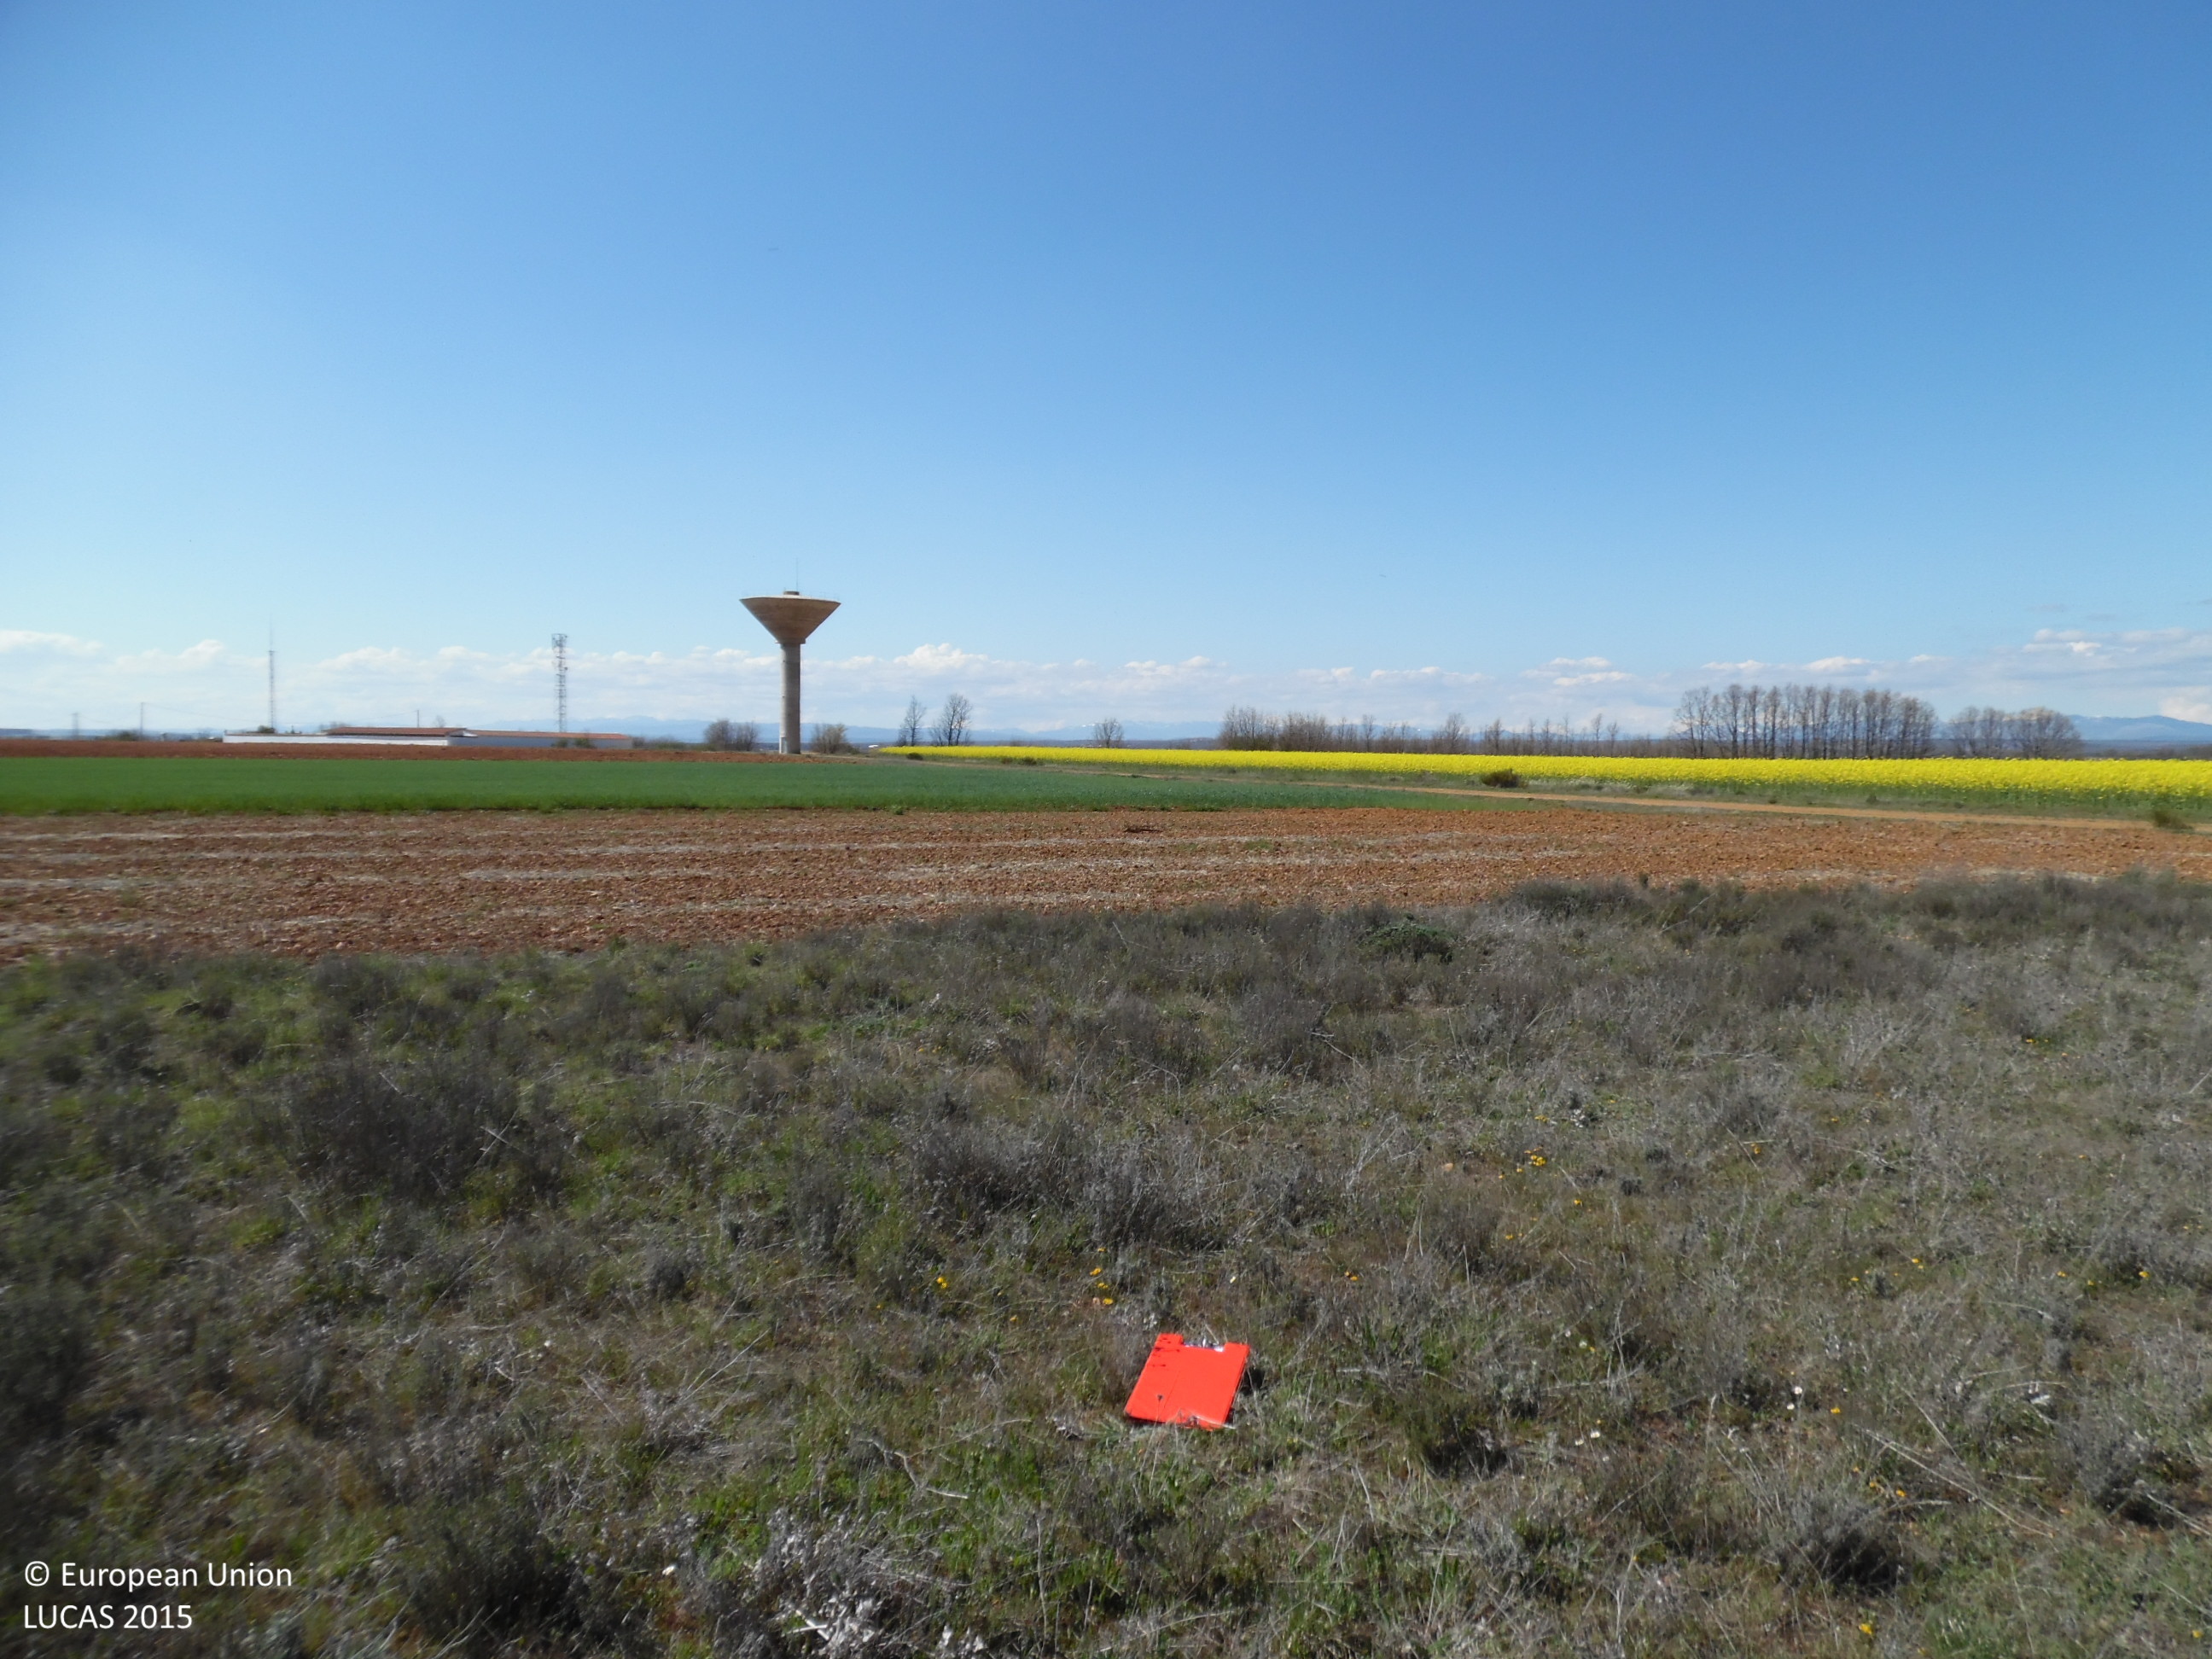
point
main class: Shrubland
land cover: Shrubland without tree cover
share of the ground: 50 - 75 %
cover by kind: shrubs 60 %, herbaceous plants 40 %
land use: Abandoned areas
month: April
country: ES
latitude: 42.5236
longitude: -5.6925
